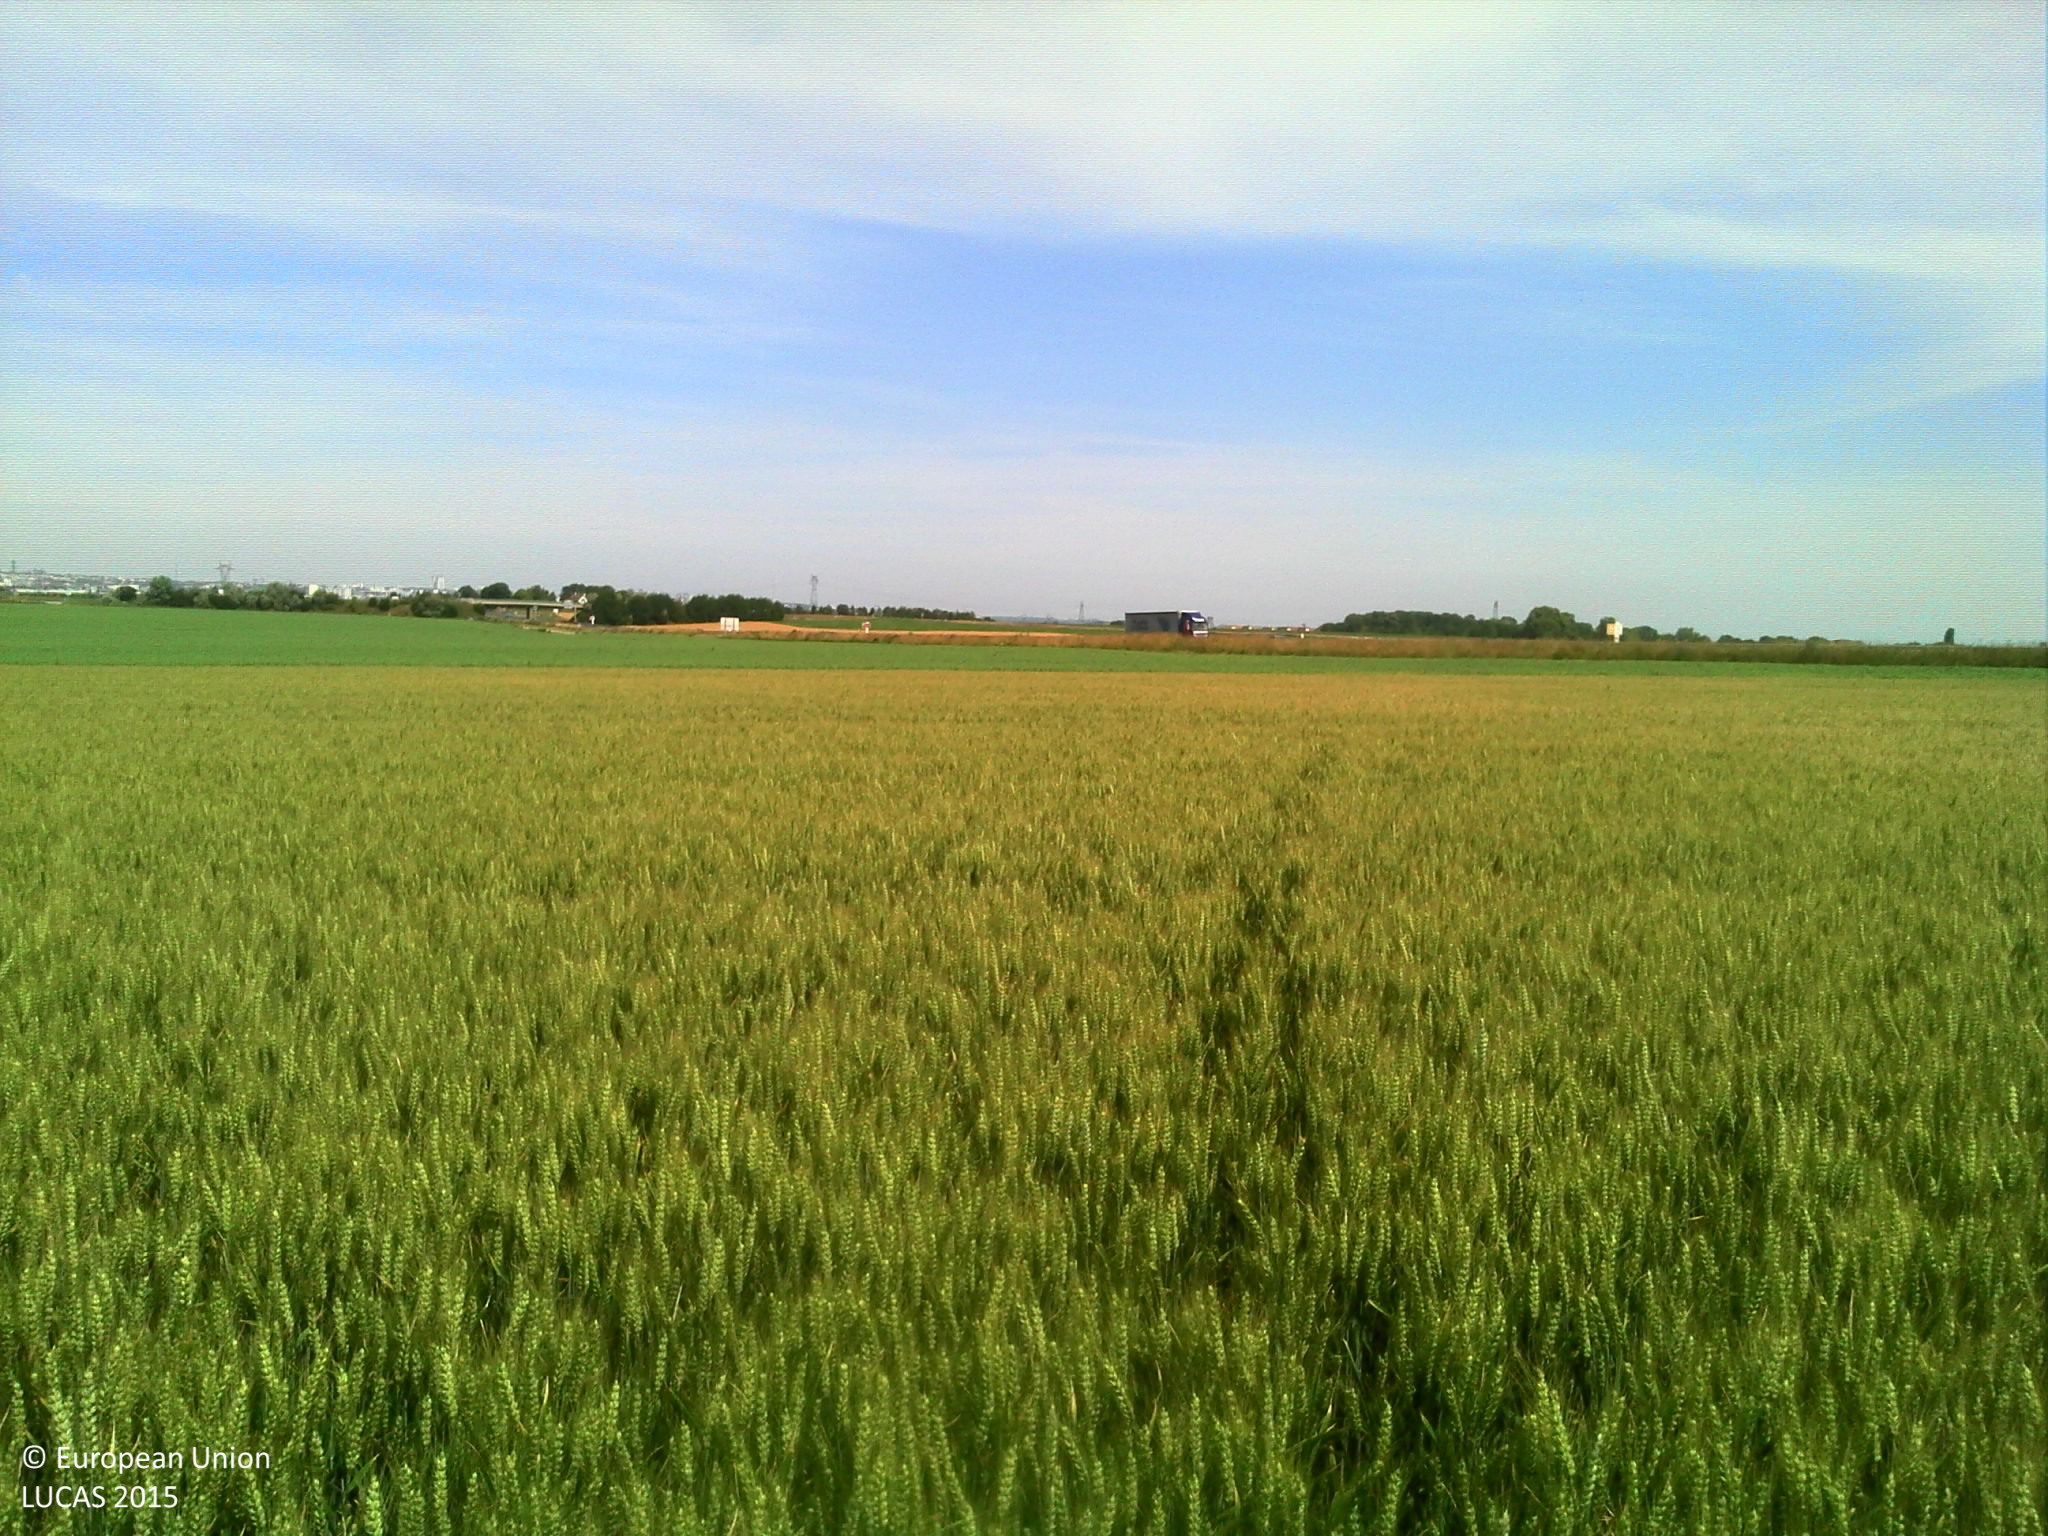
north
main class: Cropland
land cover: Common wheat
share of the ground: > 75 %
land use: Agriculture (excluding fallow land and kitchen gardens)
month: June
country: FR
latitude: 49.1159
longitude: -0.3236
